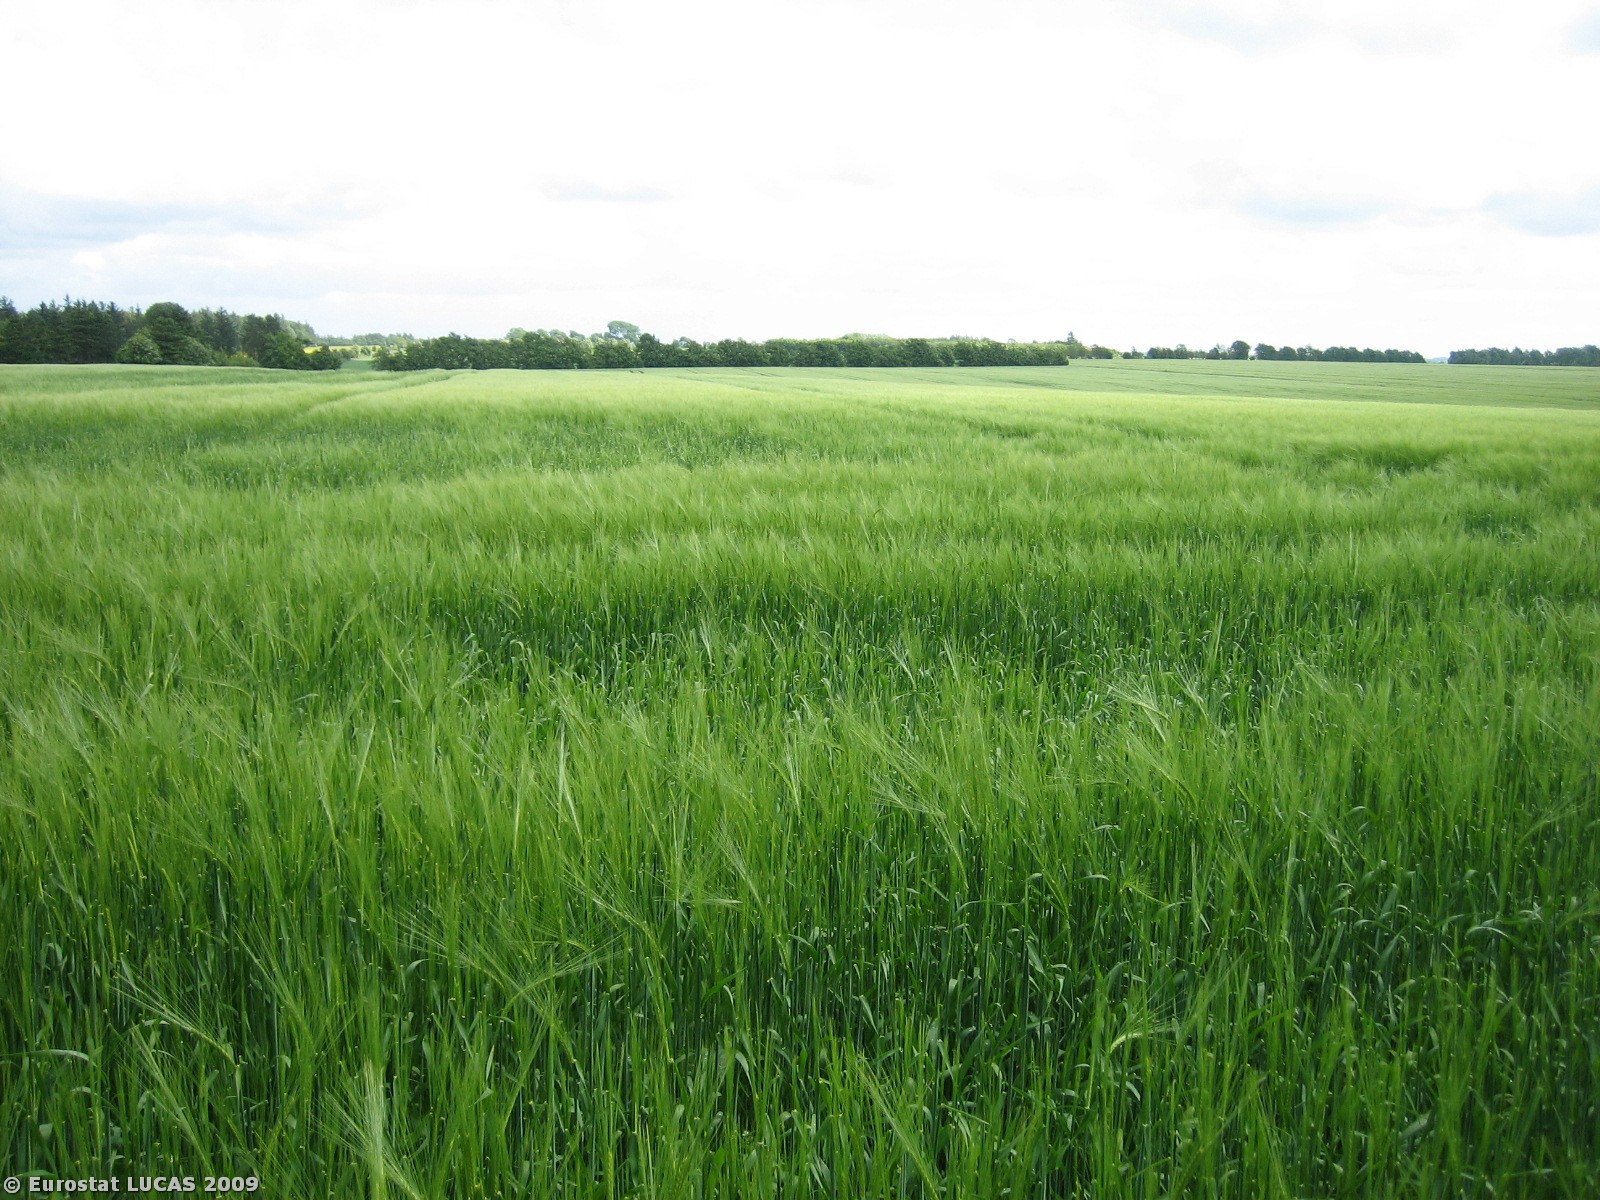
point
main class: Cropland
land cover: Barley
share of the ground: > 75 %
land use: Agriculture (excluding fallow land and kitchen gardens)
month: May
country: DK
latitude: 55.9661
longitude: 8.7677
